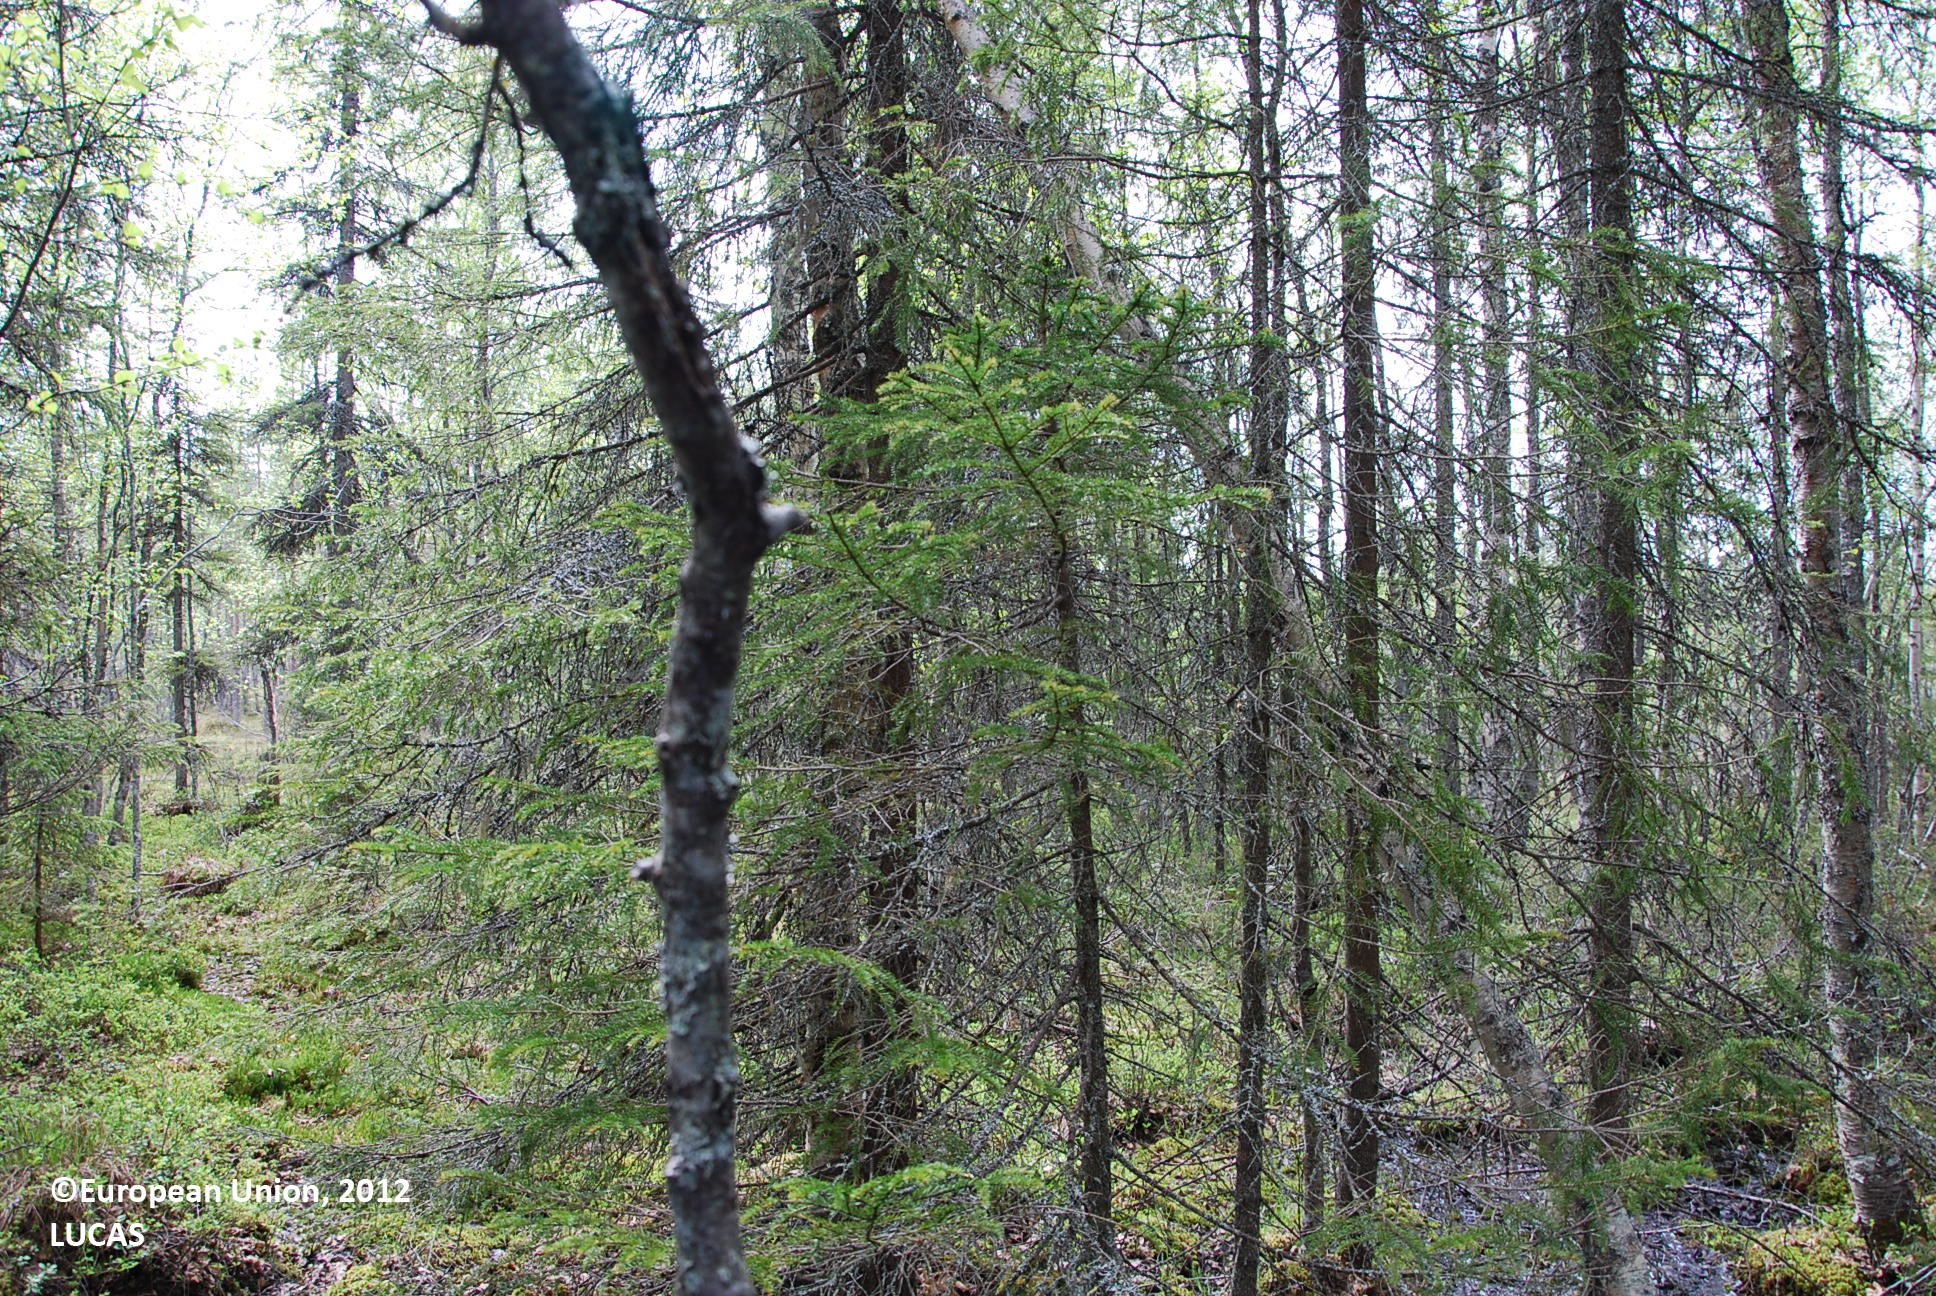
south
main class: Woodland
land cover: Spruce dominated mixed woodland
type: boreal forest
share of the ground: > 75 %
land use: Forestry
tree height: > 5 m
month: June
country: FI
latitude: 66.2062
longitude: 27.6949
